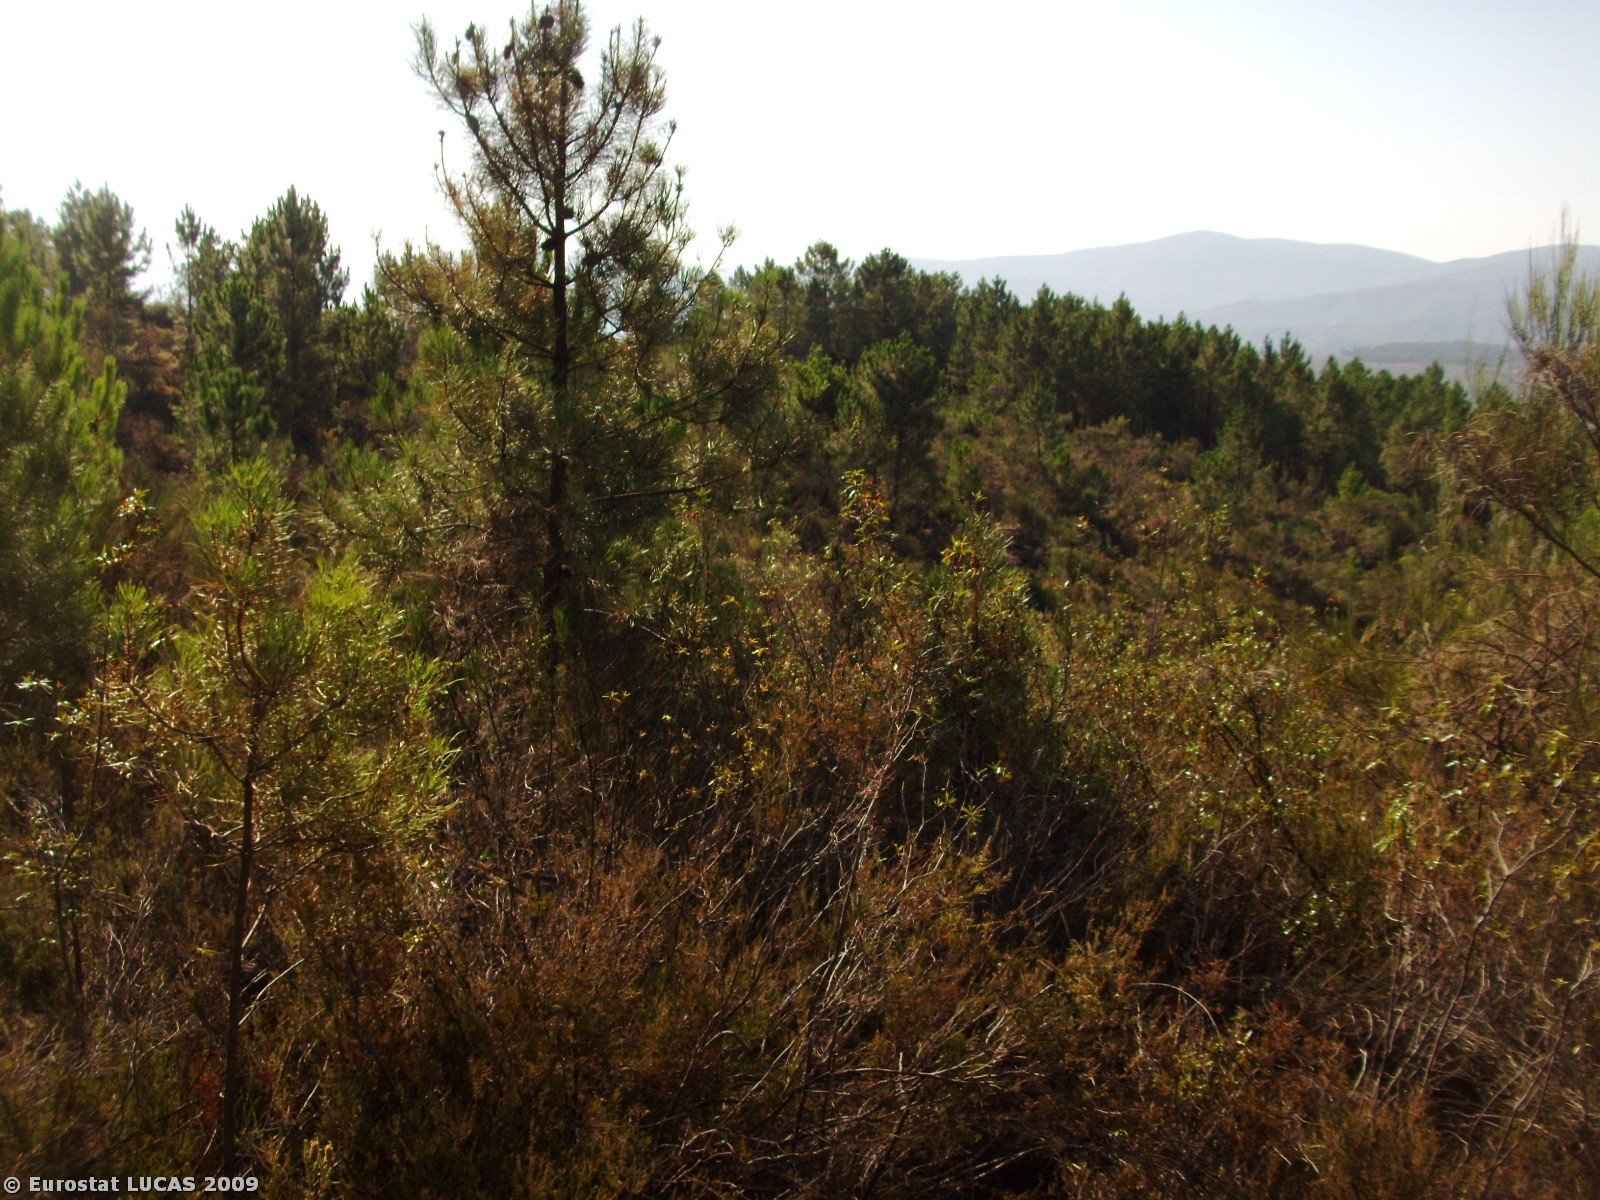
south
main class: Shrubland
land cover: Shrubland with sparse tree cover
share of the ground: > 75 %
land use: Unused
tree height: > 5 m
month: August
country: PT
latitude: 40.1737
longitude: -7.7136
